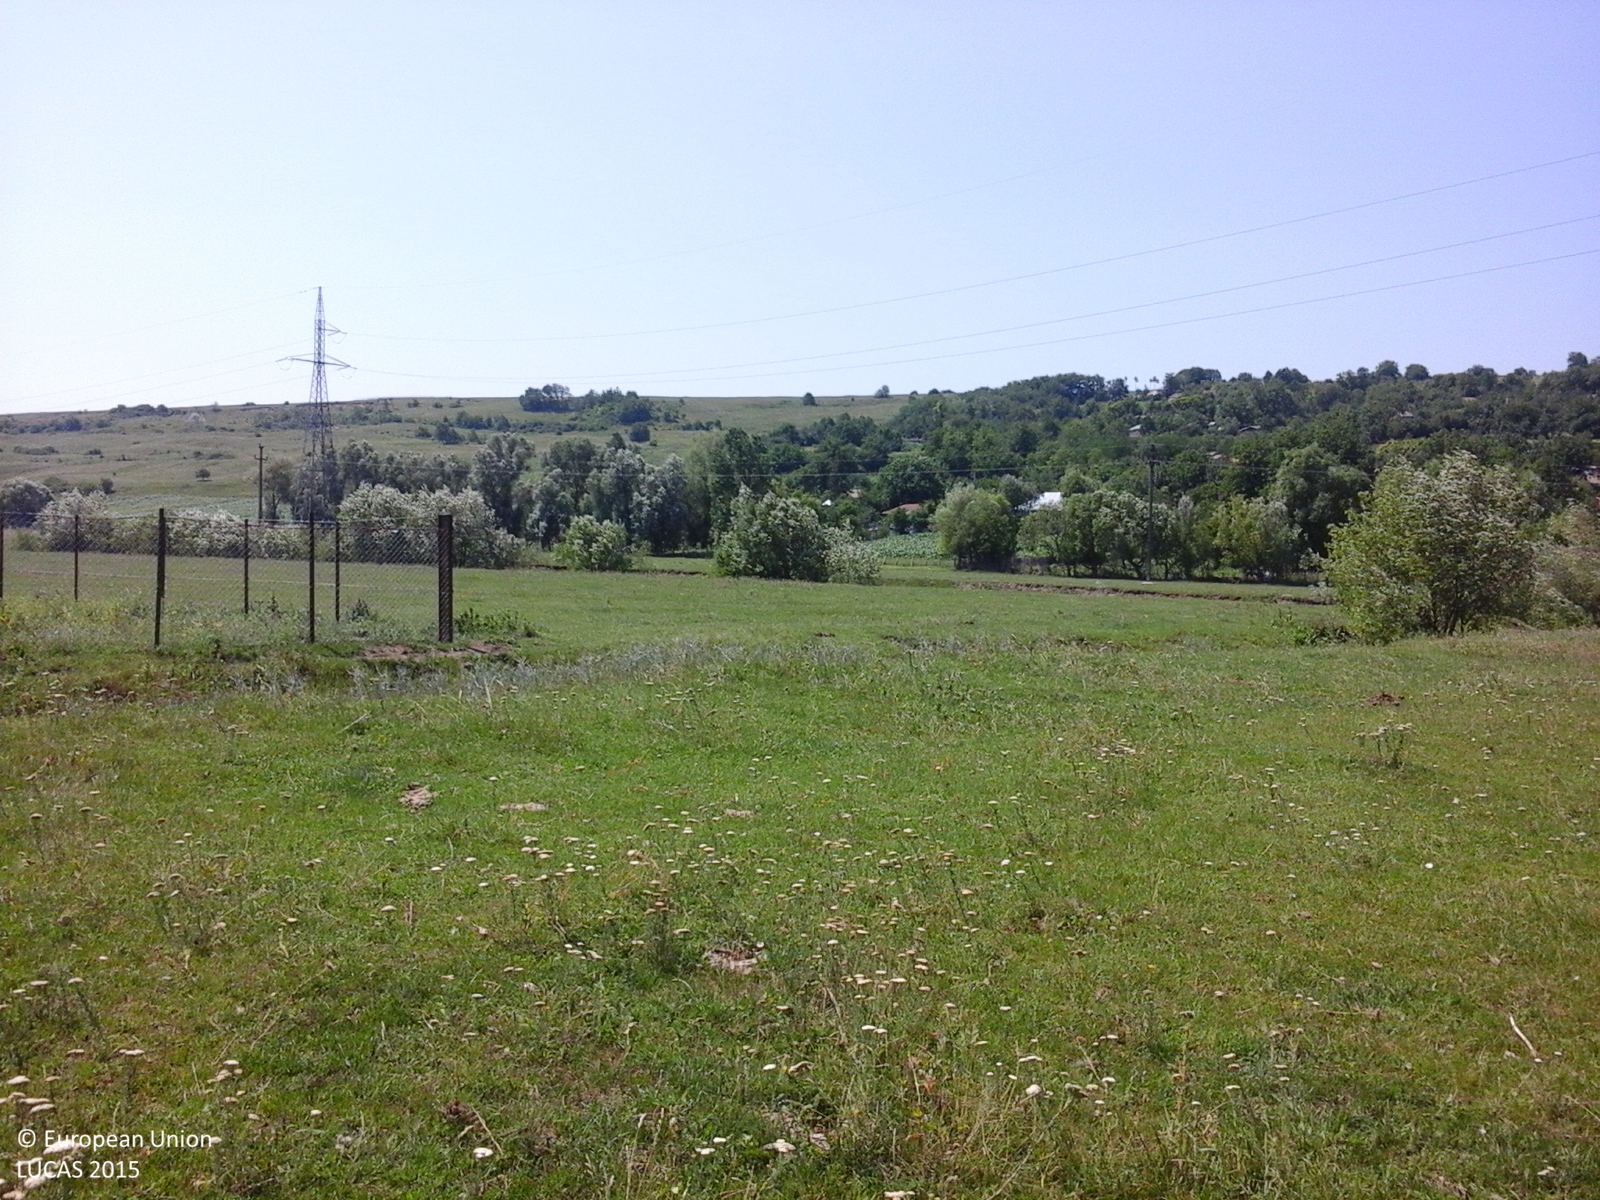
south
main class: Grassland
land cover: Grassland without tree/shrub cover
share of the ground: > 75 %
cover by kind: herbaceous plants 100 %
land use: Agriculture (excluding fallow land and kitchen gardens)
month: June
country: RO
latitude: 46.7345
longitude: 27.5047
